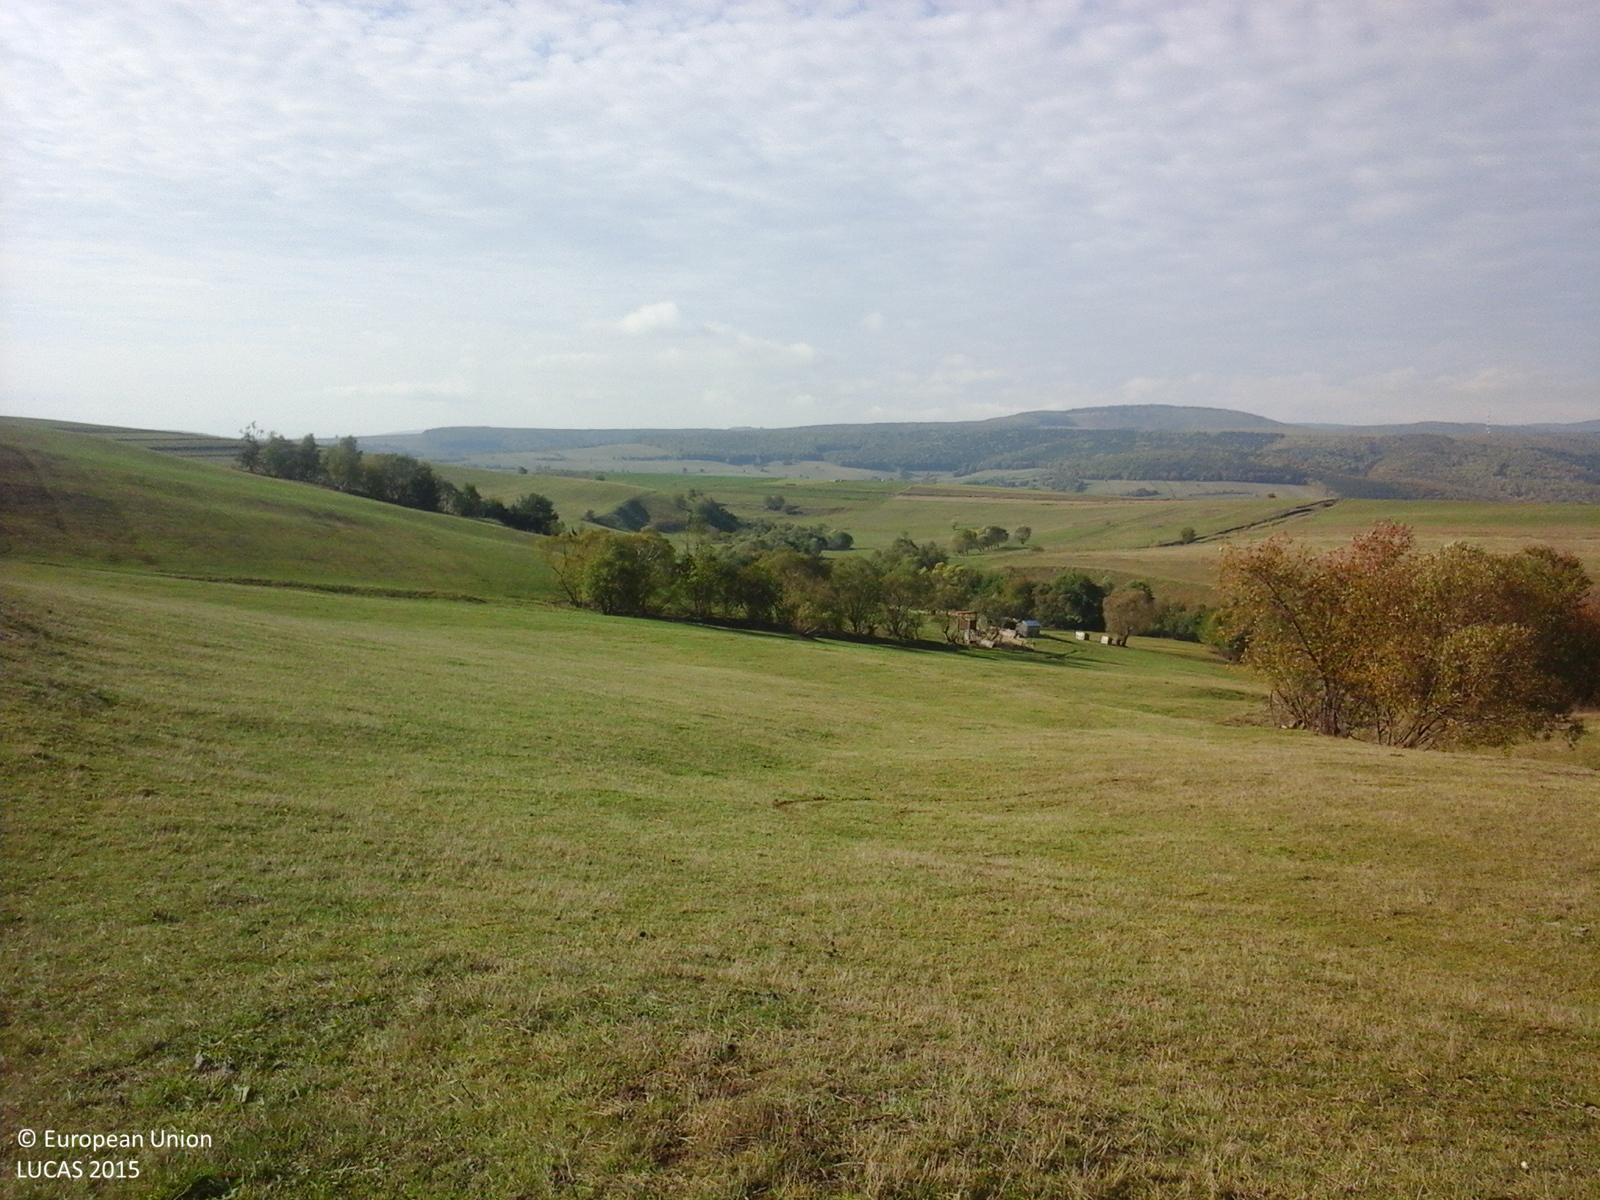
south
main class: Grassland
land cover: Grassland without tree/shrub cover
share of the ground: > 75 %
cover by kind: herbaceous plants 100 %
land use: Agriculture (excluding fallow land and kitchen gardens)
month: October
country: RO
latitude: 46.0637
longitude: 26.0584
